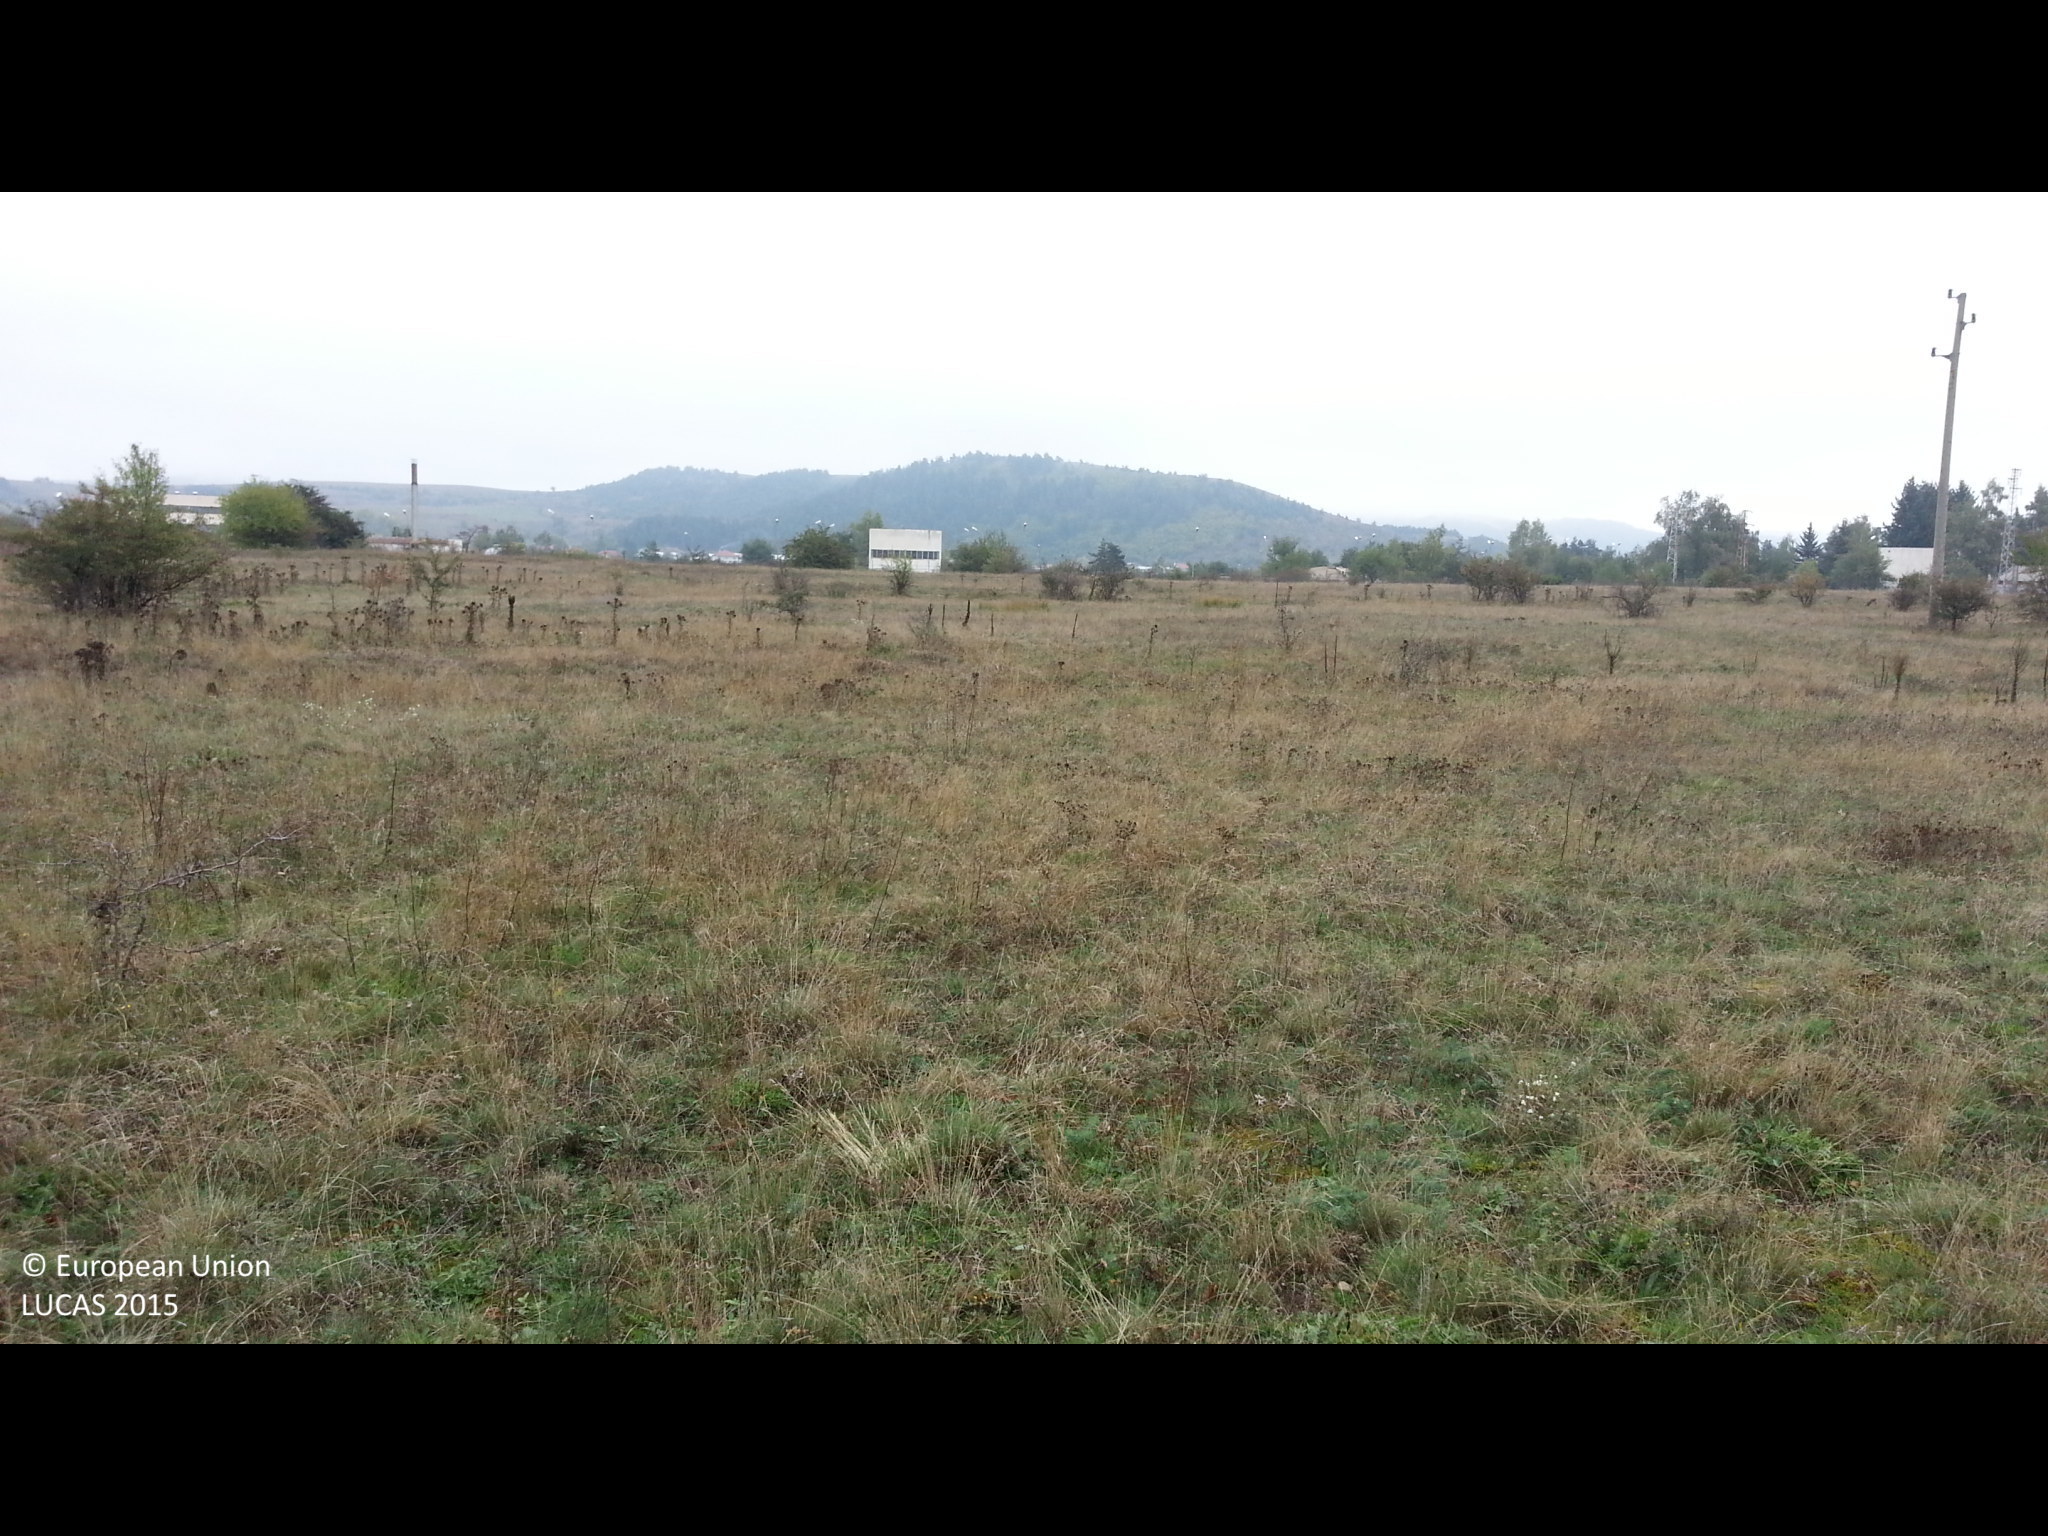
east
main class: Grassland
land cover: Grassland without tree/shrub cover
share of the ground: > 75 %
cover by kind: herbaceous plants 100 %
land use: Agriculture (excluding fallow land and kitchen gardens)
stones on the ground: < 10 %
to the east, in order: Grassland without tree/shrub cover; Electric lines; Grassland without tree/shrub cover; Grassland with sparse tree/shrub cover; Tracks; Grassland with sparse tree/shrub cover; Artificial constructions in urban areas
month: October
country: BG
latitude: 42.3608
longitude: 23.5478
